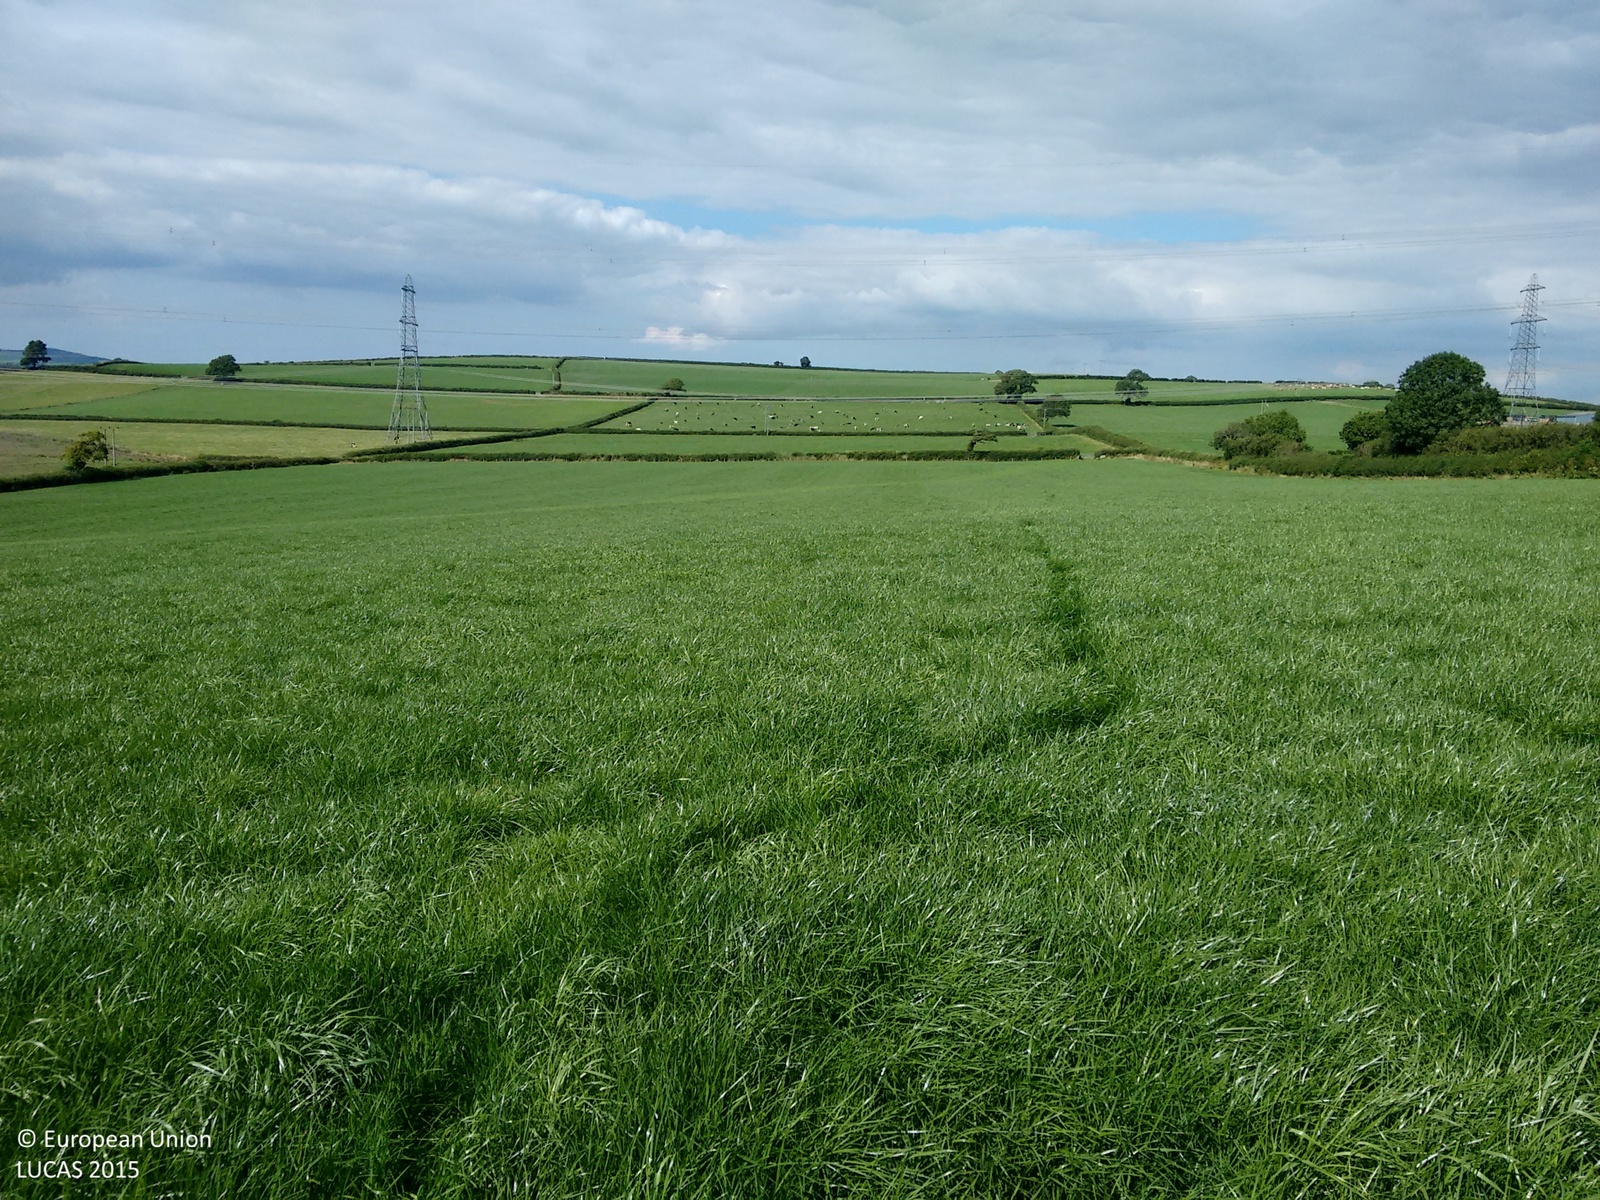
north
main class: Grassland
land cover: Grassland without tree/shrub cover
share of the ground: > 75 %
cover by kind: herbaceous plants 100 %
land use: Agriculture (excluding fallow land and kitchen gardens)
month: August
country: GB
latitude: 51.7947
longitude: -4.4738
